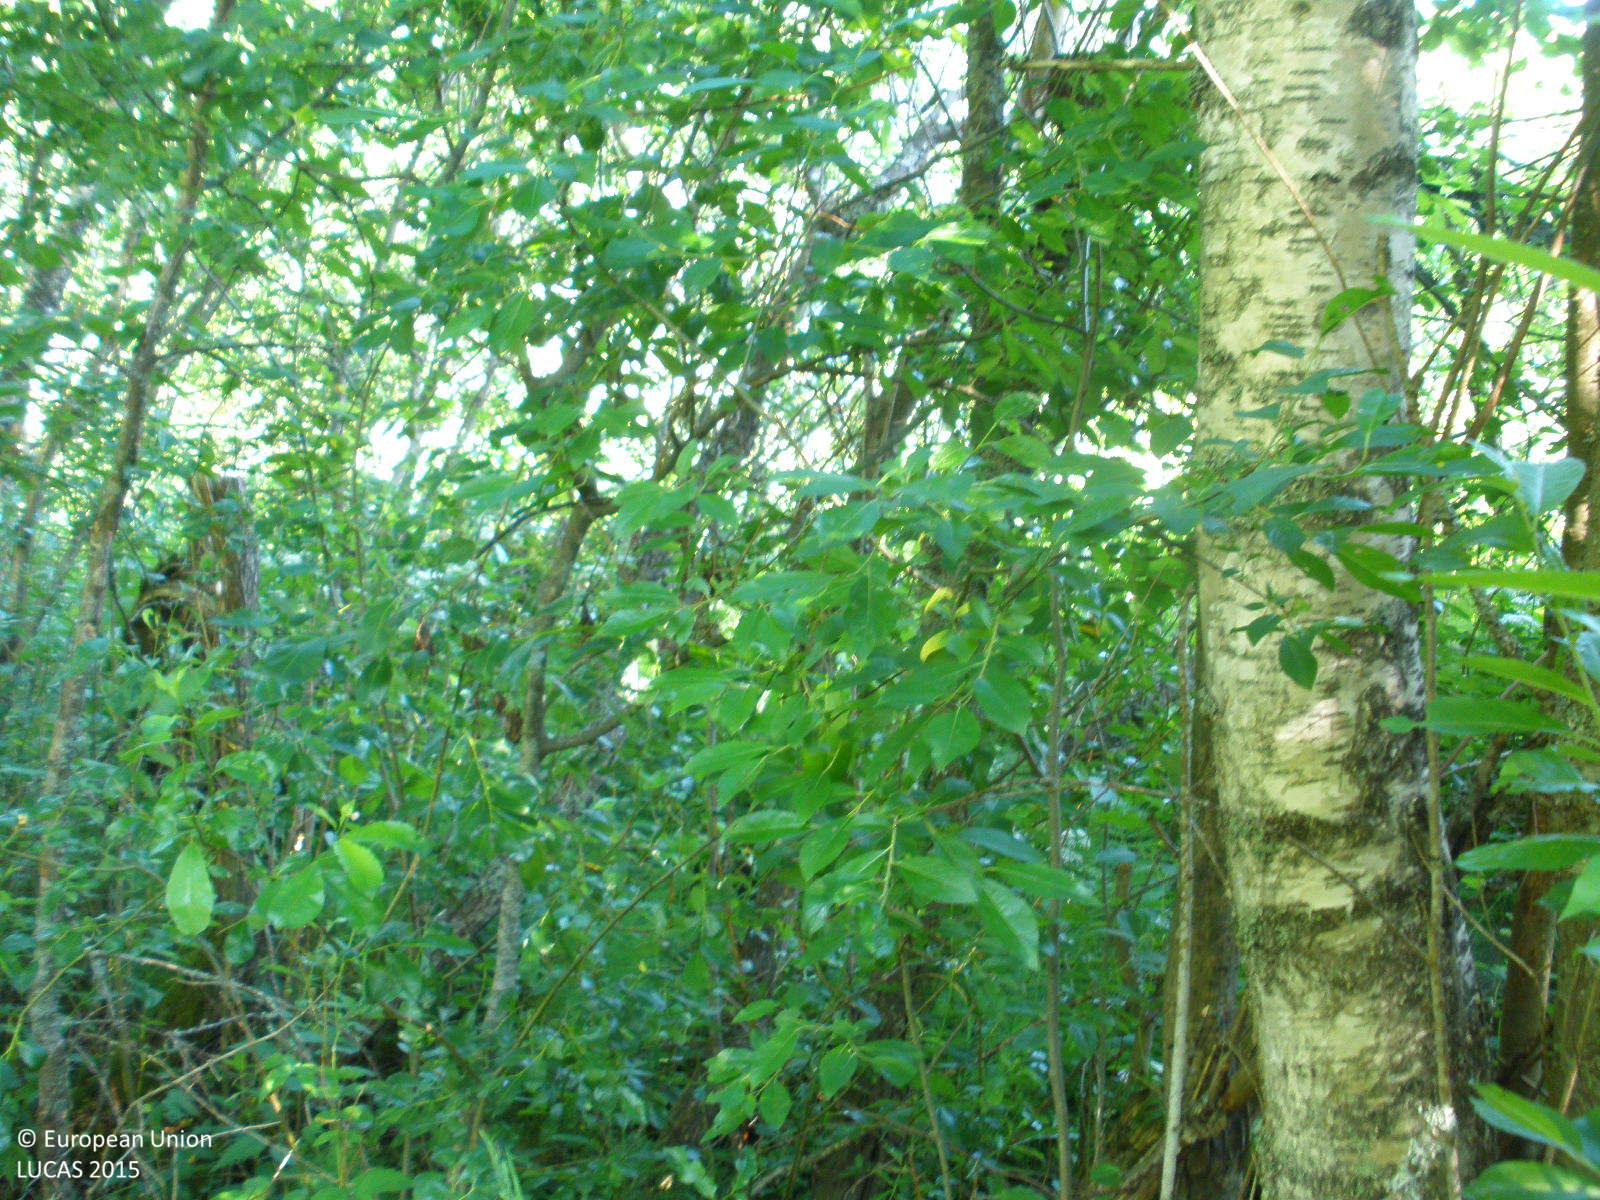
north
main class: Woodland
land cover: Broadleaved woodland
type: boreal forest
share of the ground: > 75 %
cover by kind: broadleaved forest trees 80 %, shrubs 10 %, coniferous forest trees 5 %, herbaceous plants 5 %
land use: Forestry
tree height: > 5 m
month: July
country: FI
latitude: 61.0641
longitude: 24.9909
